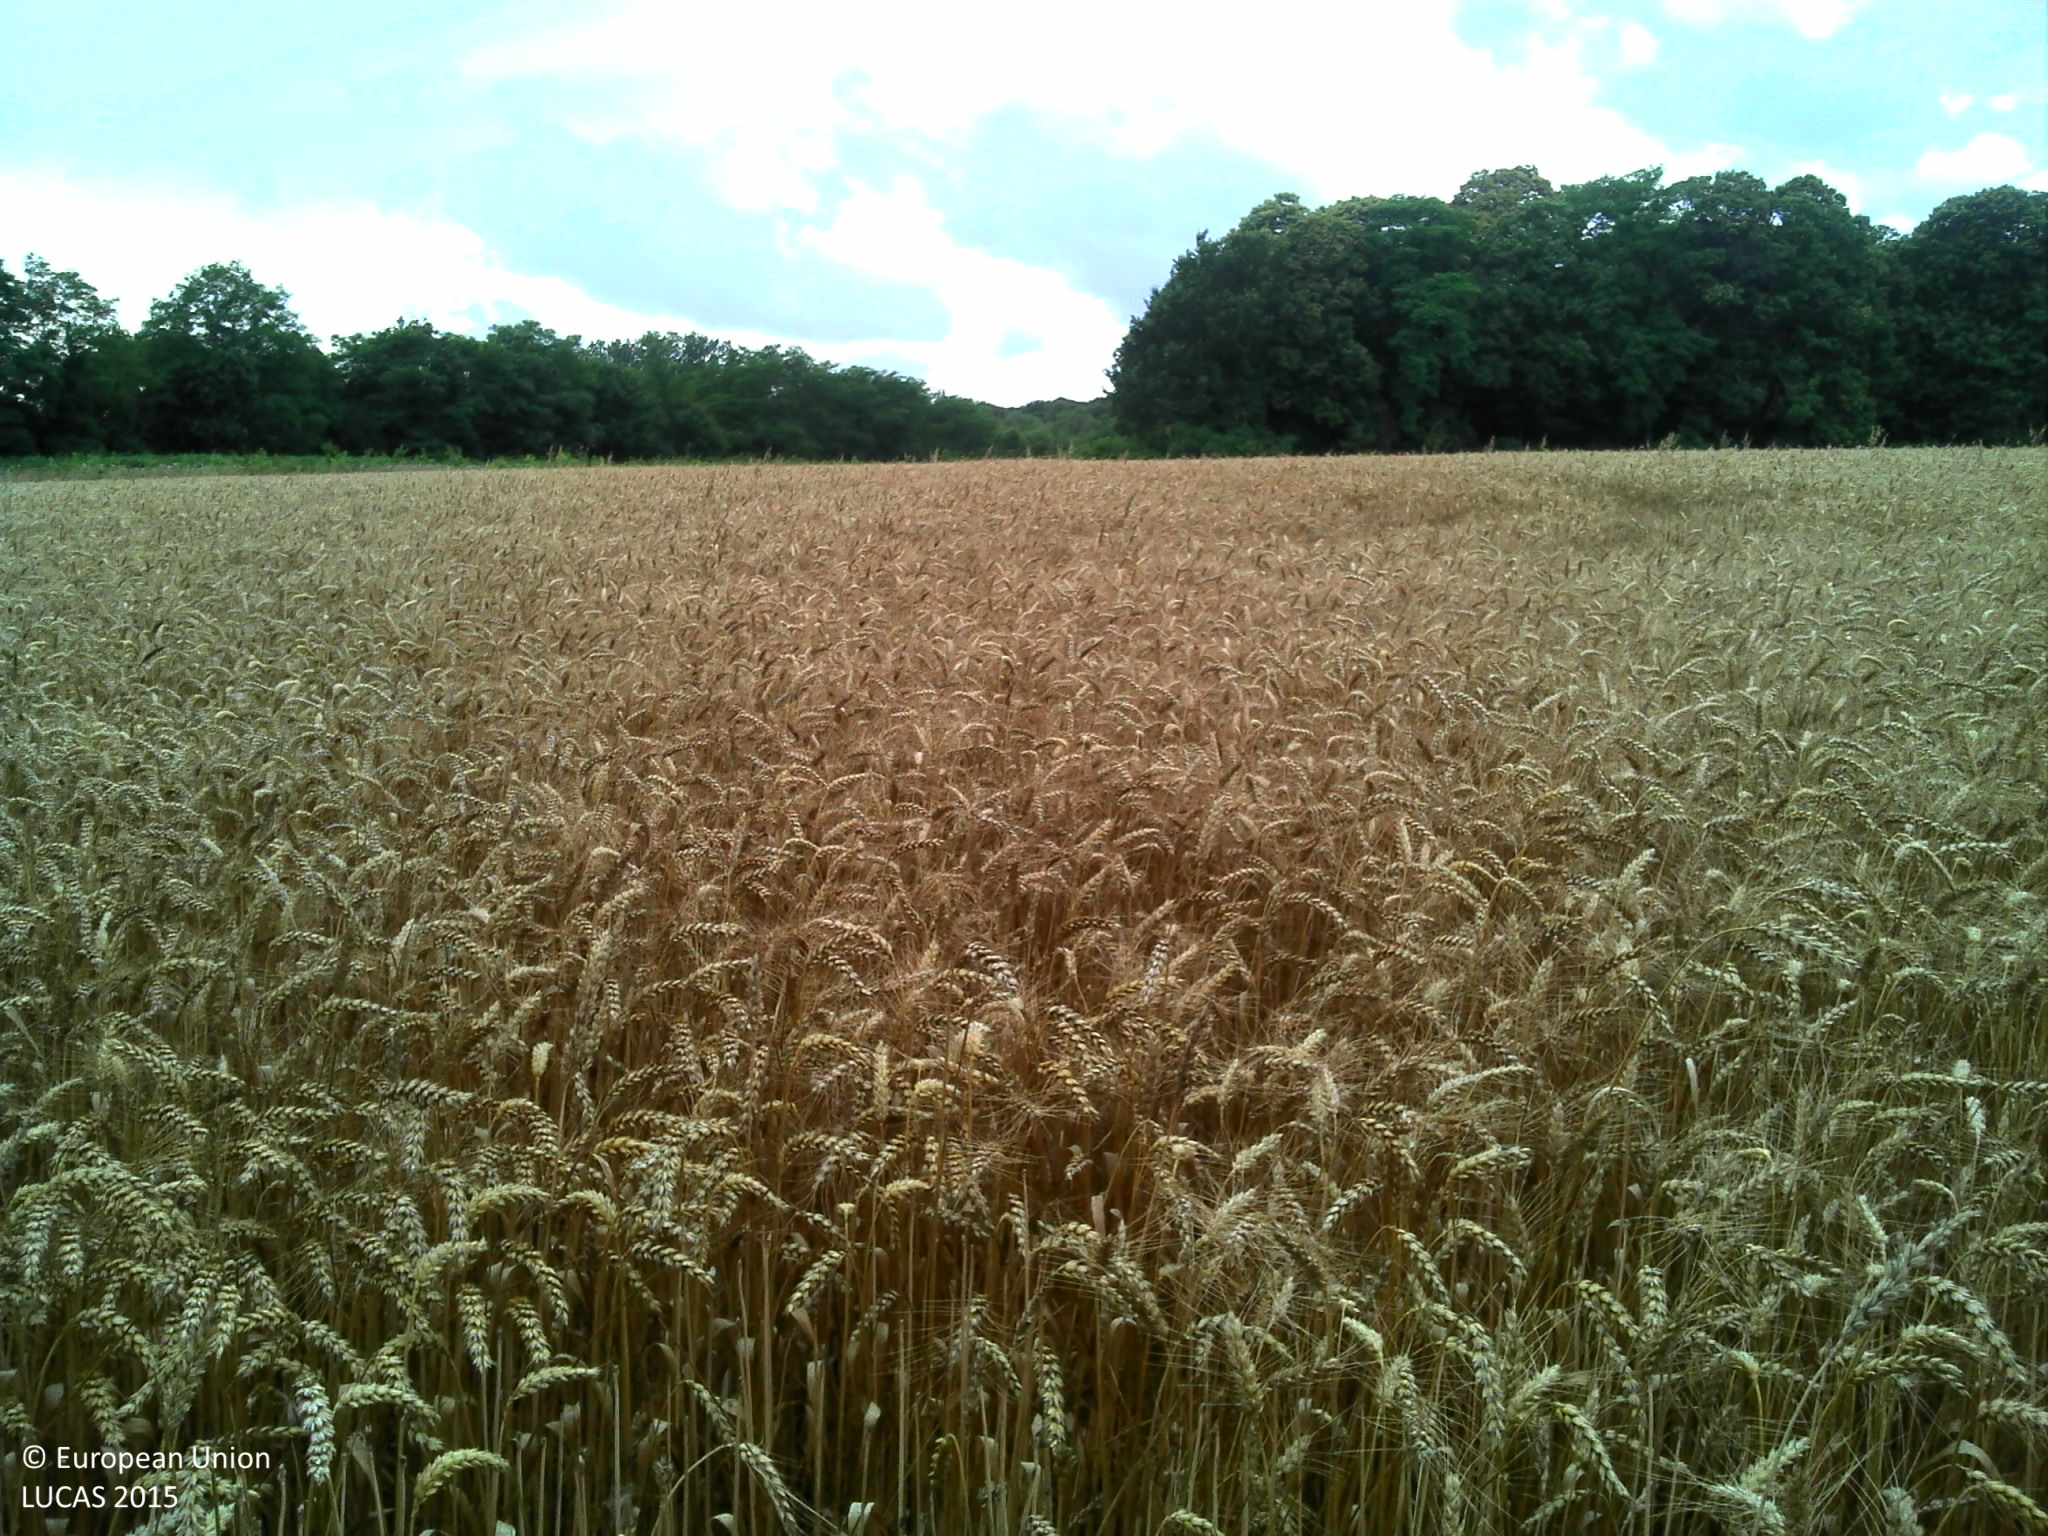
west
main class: Cropland
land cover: Common wheat
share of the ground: > 75 %
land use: Agriculture (excluding fallow land and kitchen gardens)
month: July
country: FR
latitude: 47.8295
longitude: -3.4740
